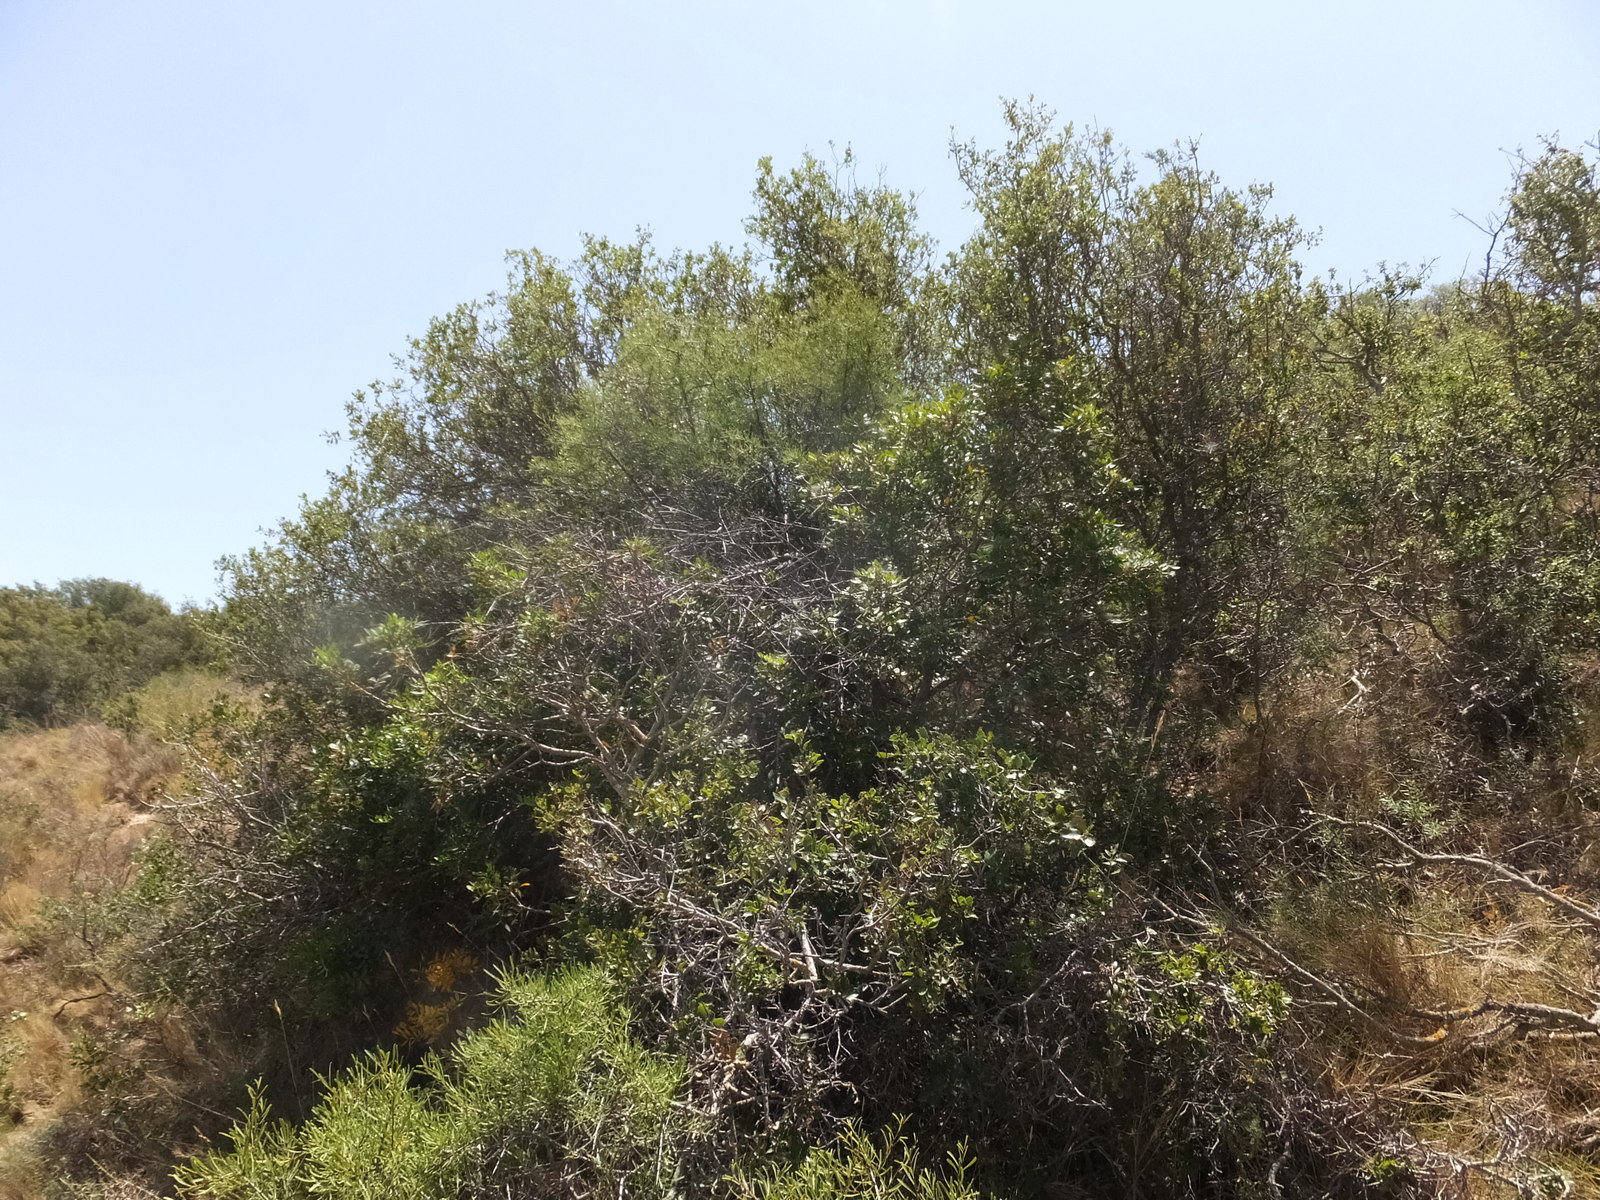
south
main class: Woodland
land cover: Broadleaved woodland
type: broadleaved evergreen forest
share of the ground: > 75 %
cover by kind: broadleaved forest trees 60 %, shrubs 35 %, coniferous forest trees 5 %
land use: Forestry
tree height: < 5 m
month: July
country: ES
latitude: 41.4226
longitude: 0.4762
